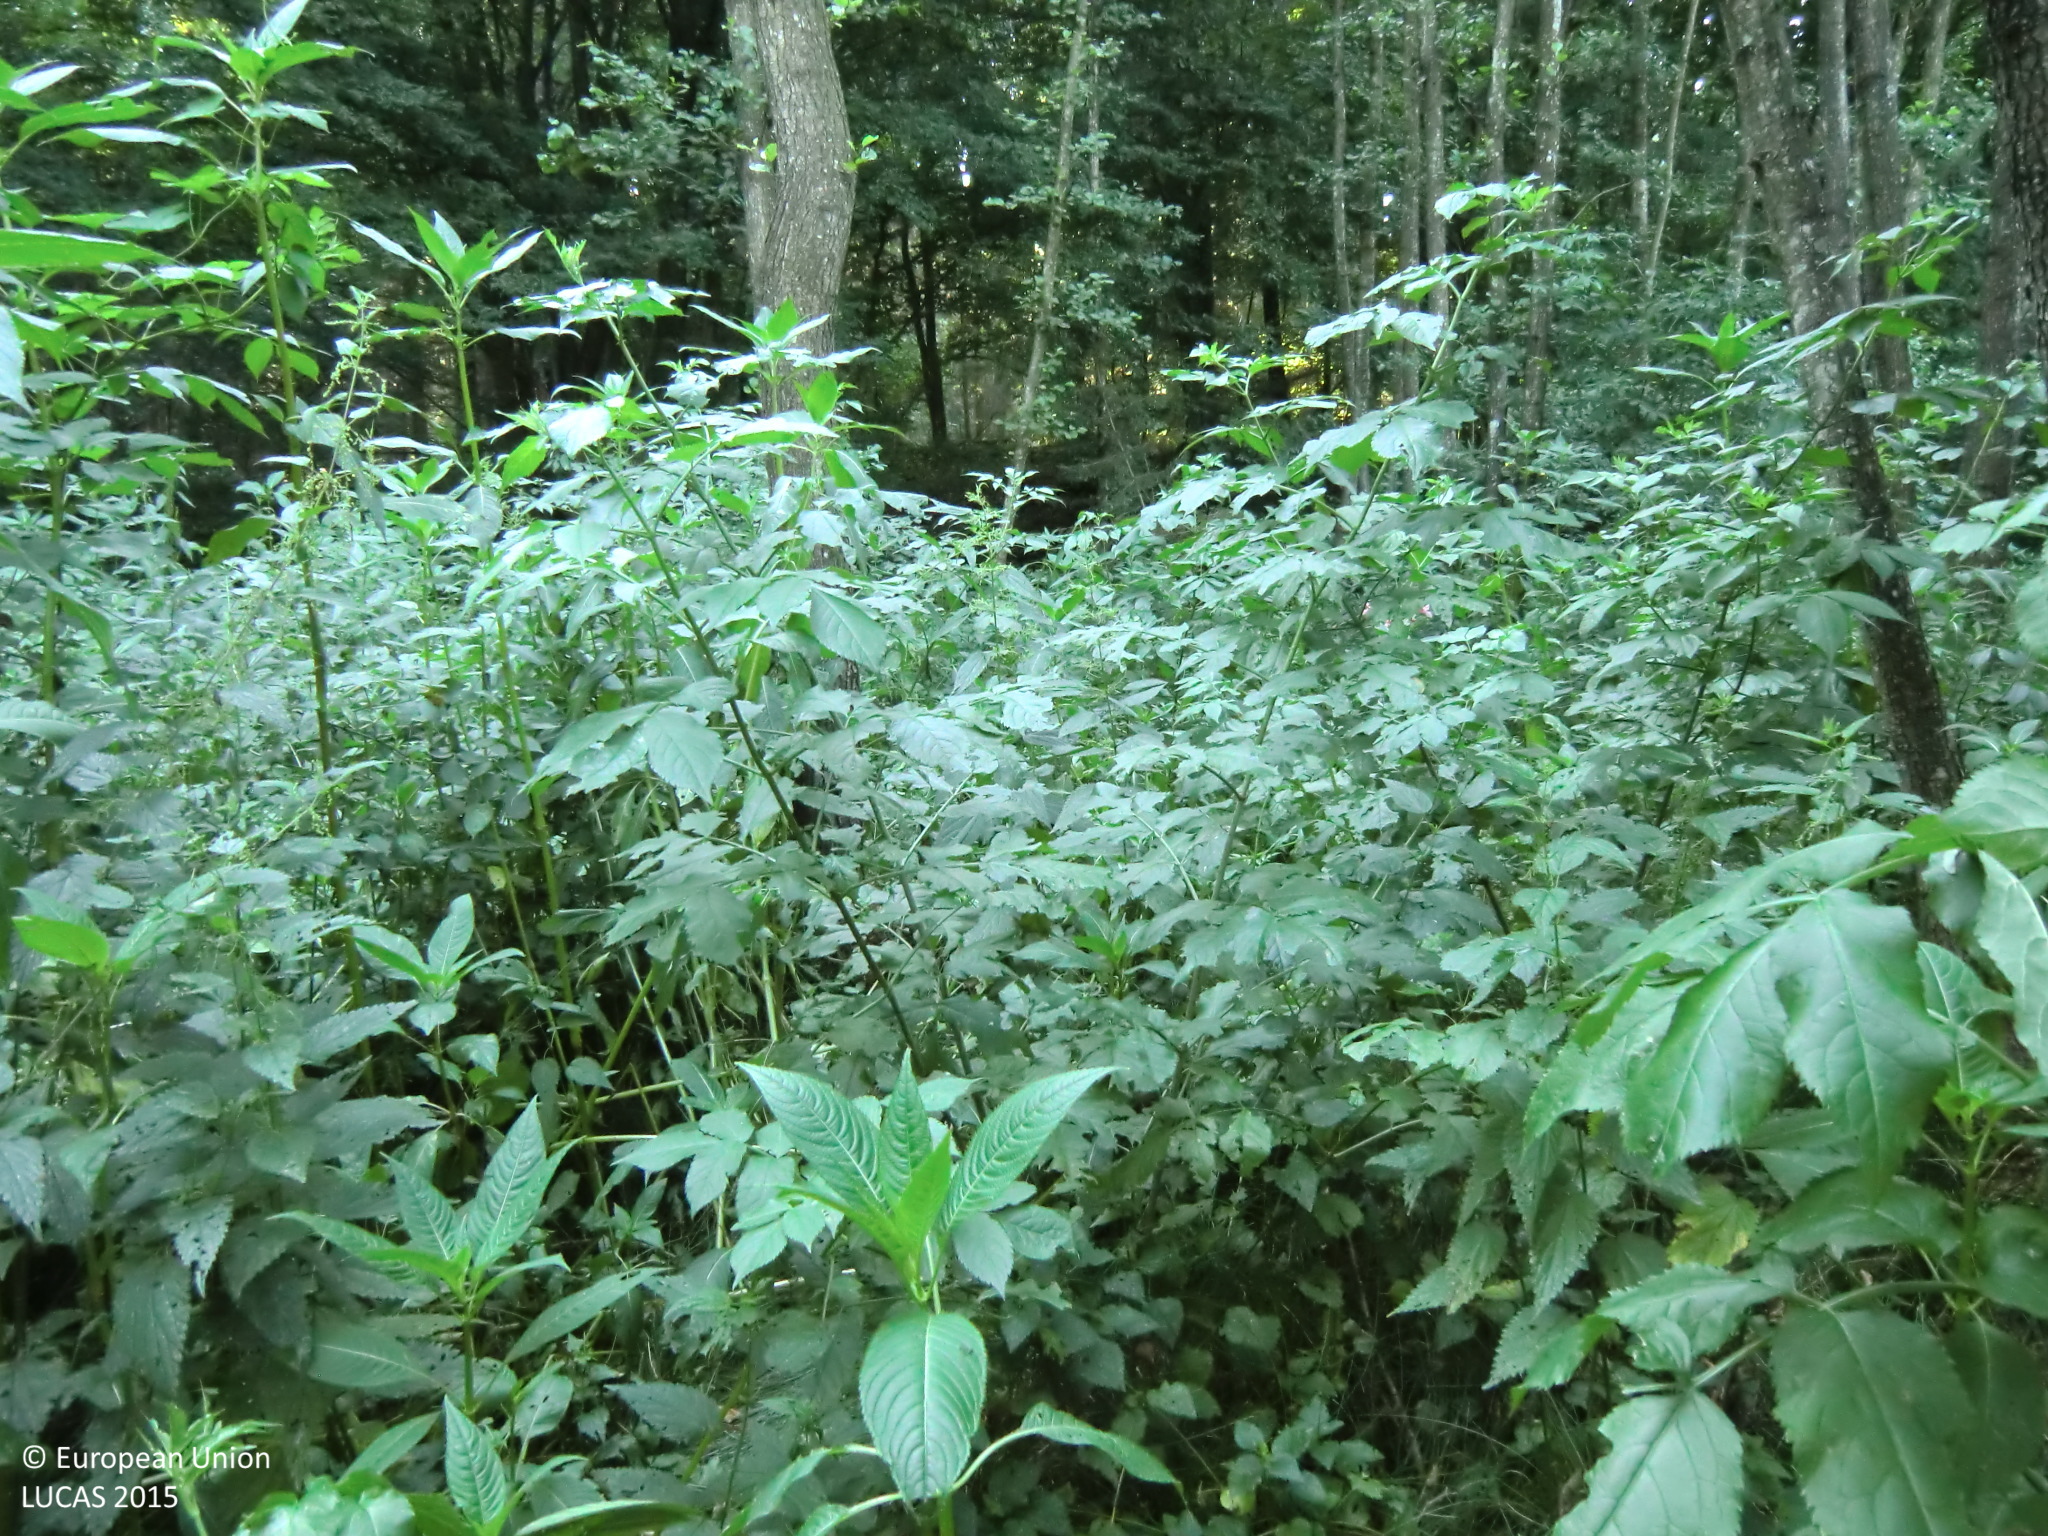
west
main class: Woodland
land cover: Broadleaved woodland
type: floodplain forest
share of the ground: > 75 %
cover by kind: broadleaved forest trees 75 %, herbaceous plants 25 %
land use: Forestry
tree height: > 5 m
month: July
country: AT
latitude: 47.0247
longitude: 16.1195
